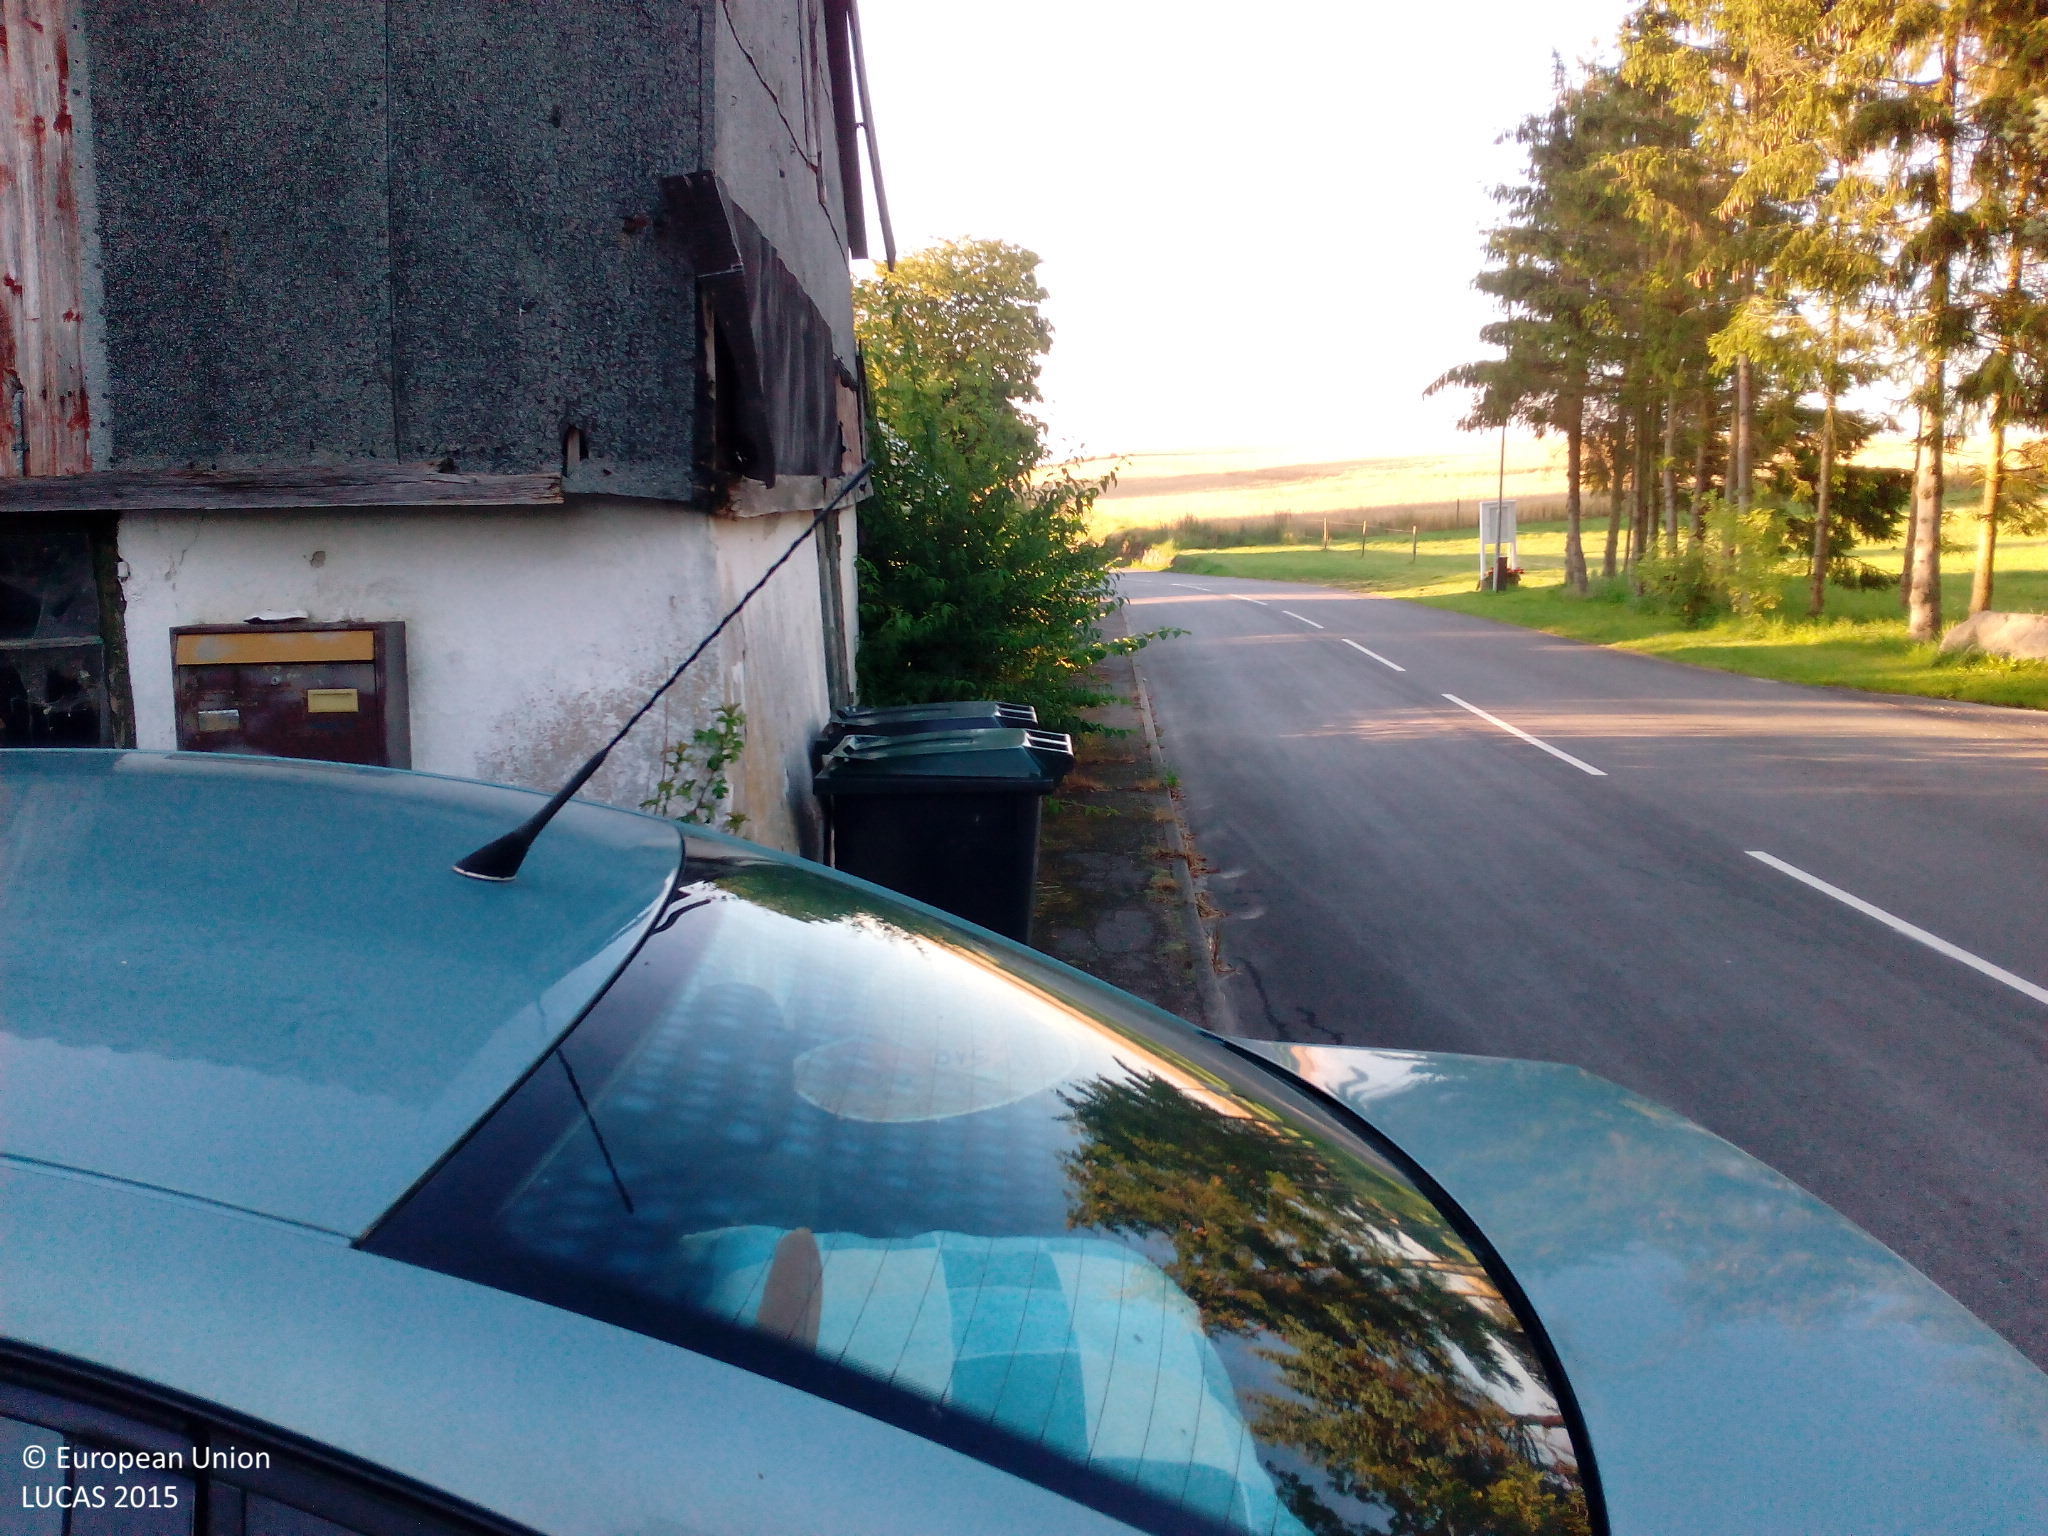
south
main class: Cropland
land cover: Common wheat
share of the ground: > 75 %
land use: Agriculture (excluding fallow land and kitchen gardens)
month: August
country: DK
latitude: 55.5640
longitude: 11.7902
